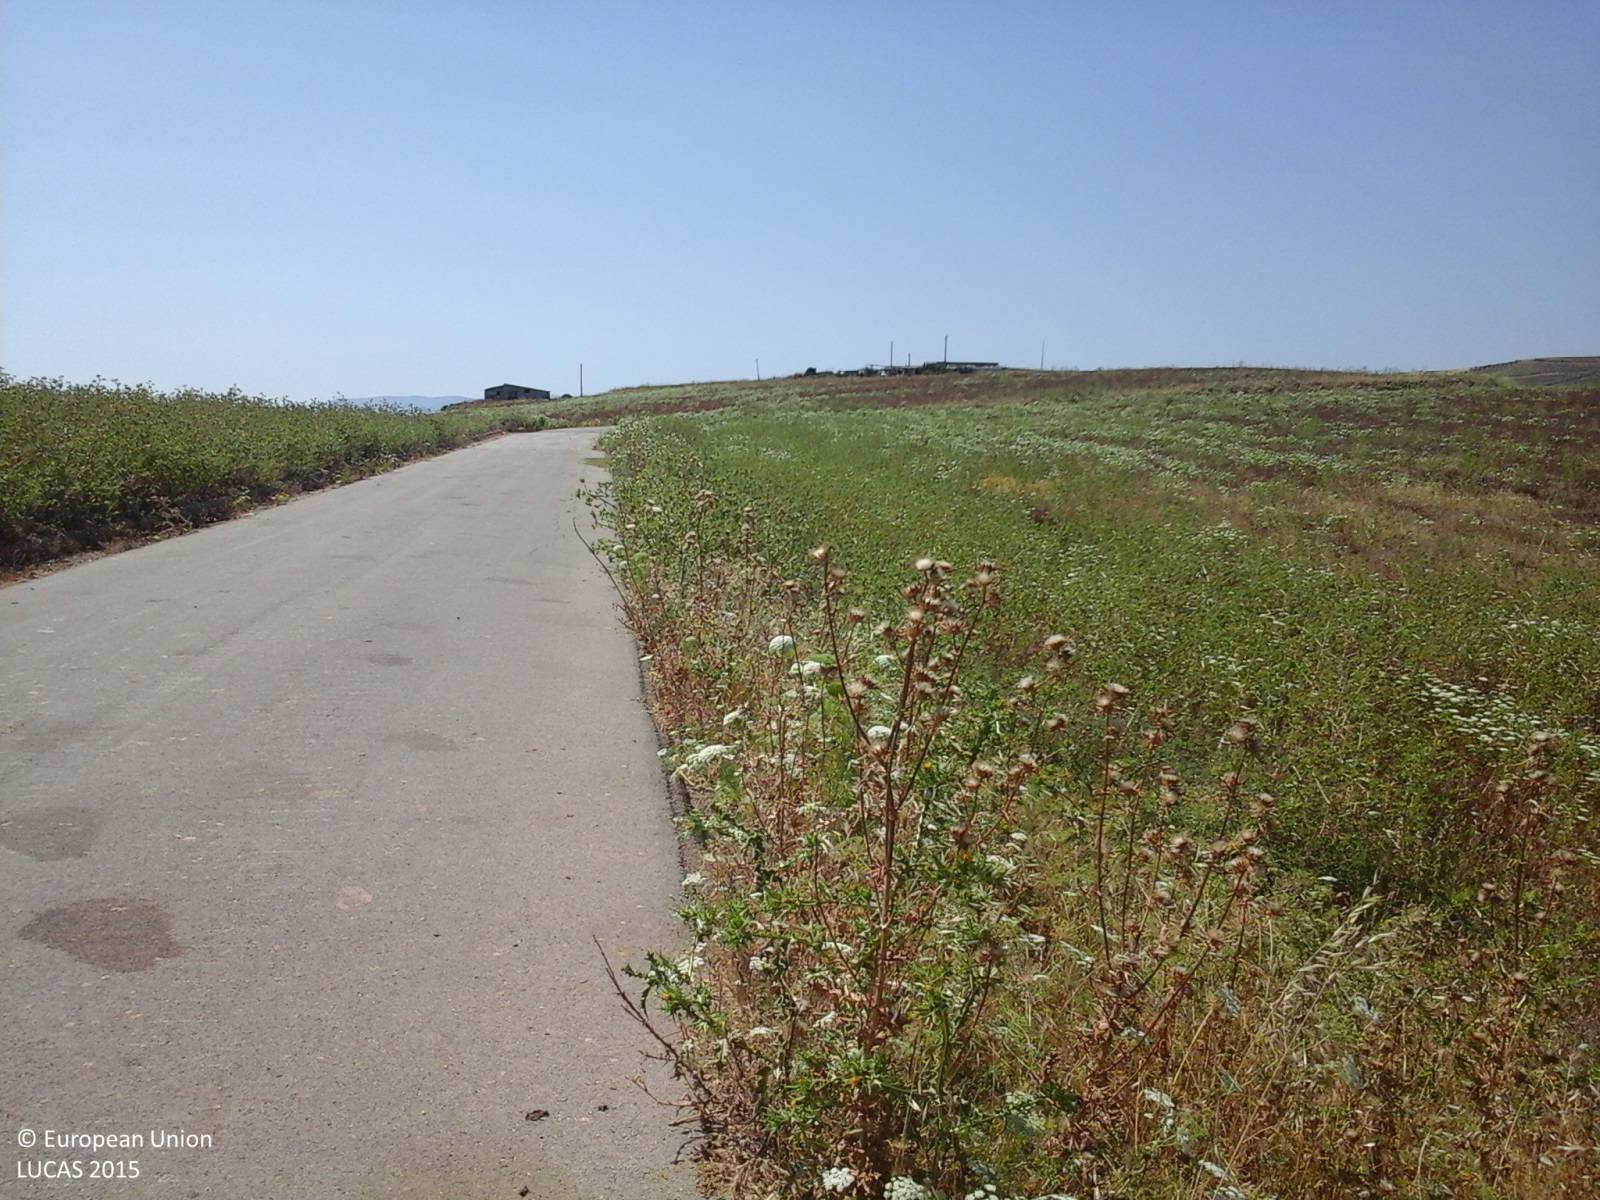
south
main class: Cropland
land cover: Dry pulses
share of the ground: > 75 %
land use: Agriculture (excluding fallow land and kitchen gardens)
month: July
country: IT
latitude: 37.8611
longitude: 13.0805
